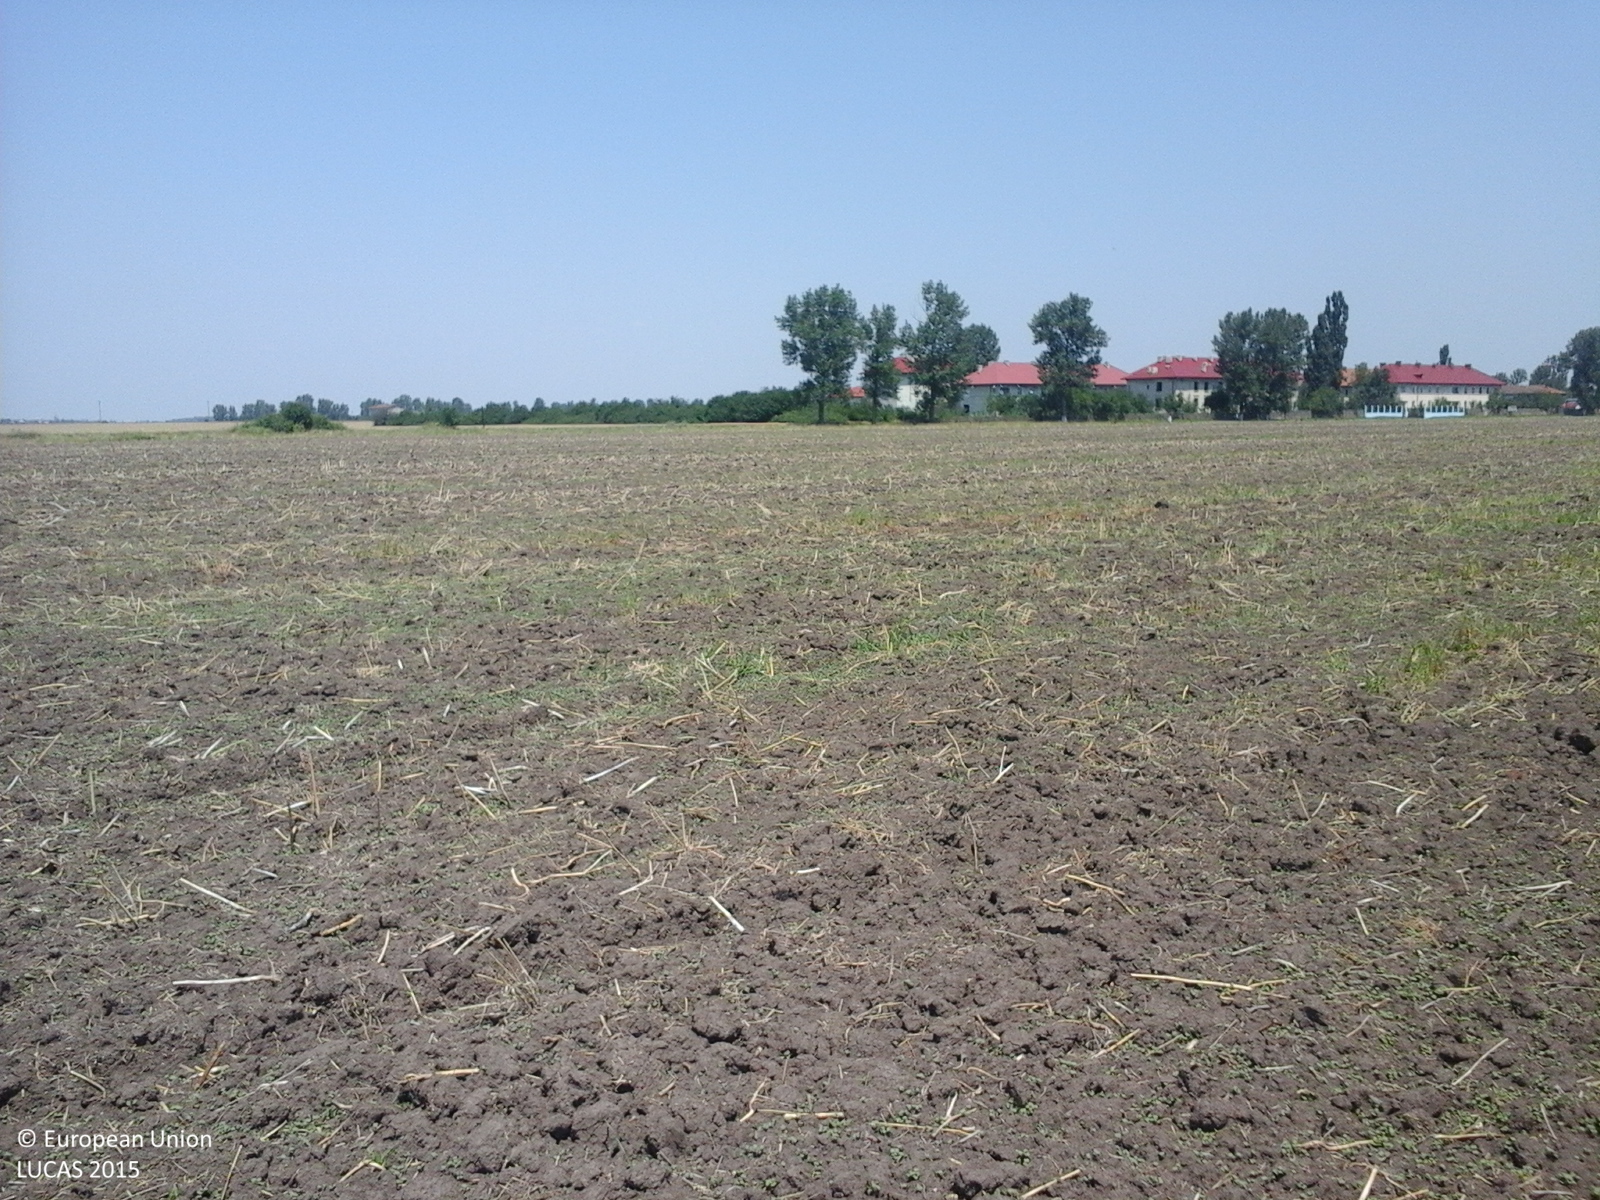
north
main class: Cropland
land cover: Rape and turnip rape
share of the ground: < 10 %
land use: Agriculture (excluding fallow land and kitchen gardens)
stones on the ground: < 10 %
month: July
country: RO
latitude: 44.3562
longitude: 24.9714
